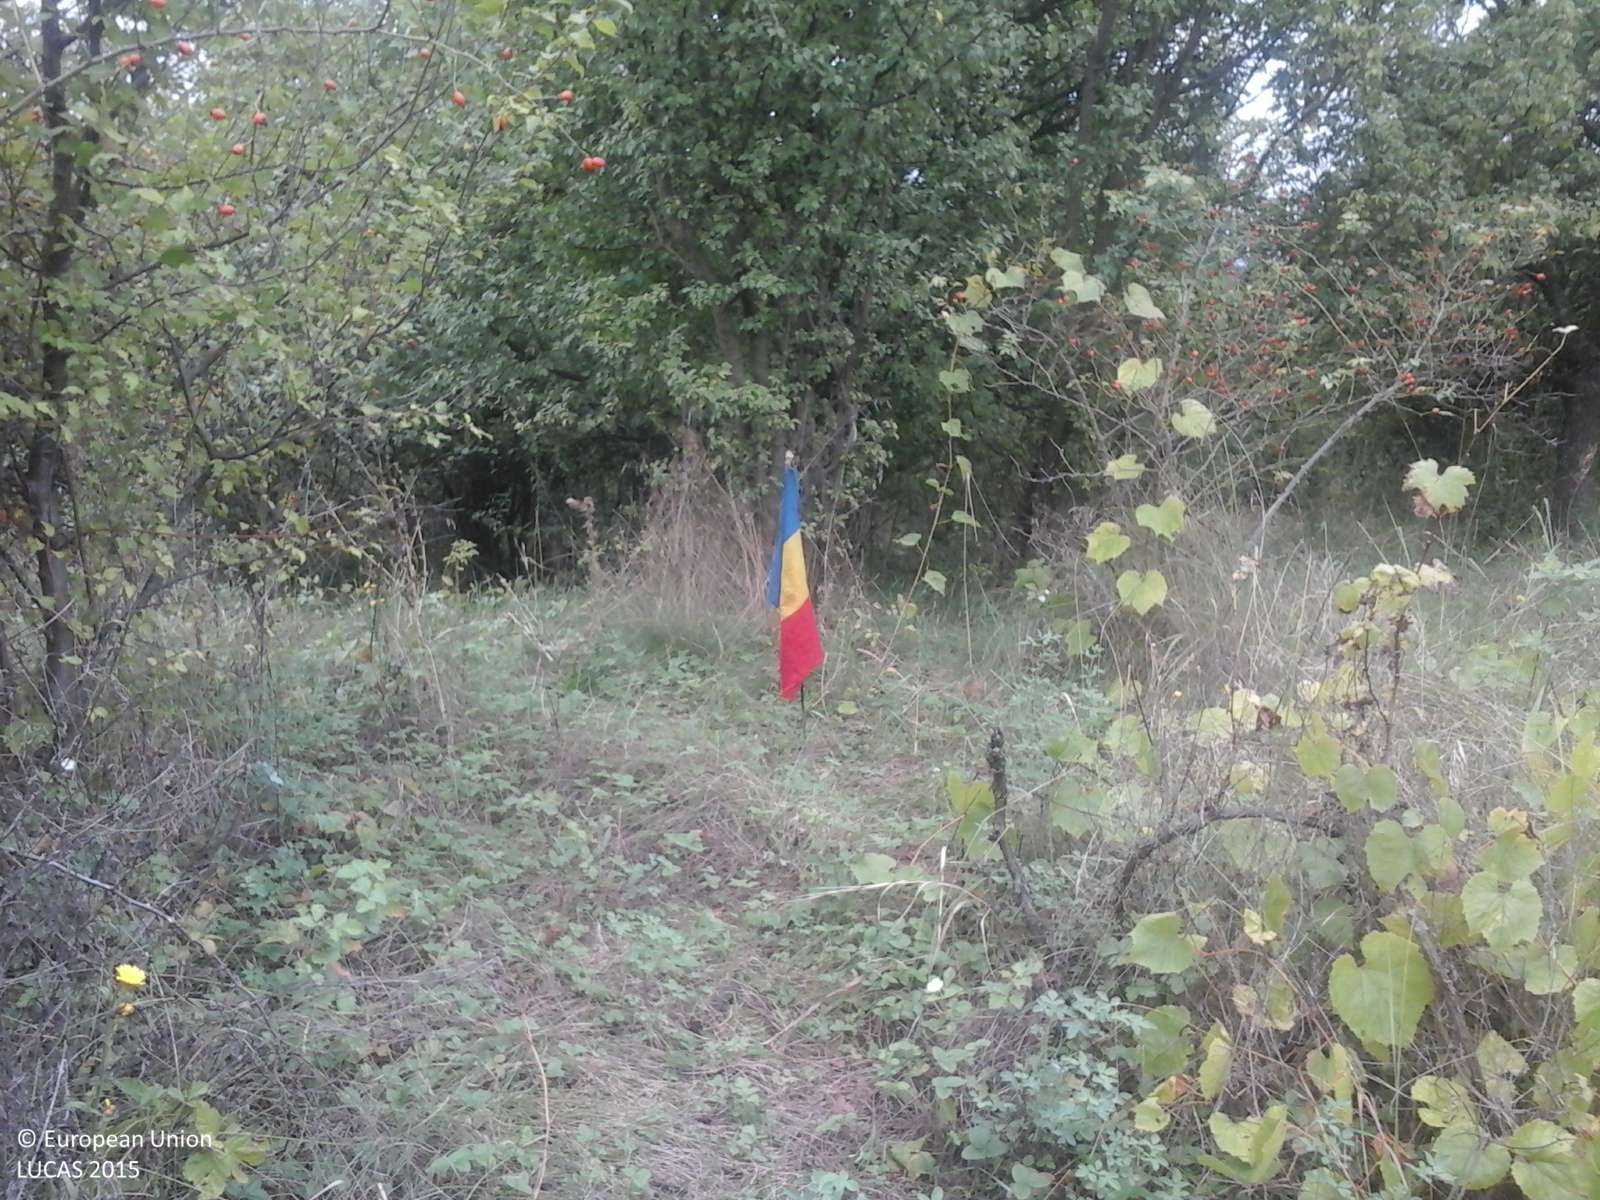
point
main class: Cropland
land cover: Other fruit trees and berries
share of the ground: > 75 %
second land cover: Grassland without tree/shrub cover
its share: > 75 %
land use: Agriculture (excluding fallow land and kitchen gardens)
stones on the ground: < 10 %
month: September
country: RO
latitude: 47.2494
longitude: 22.0594
